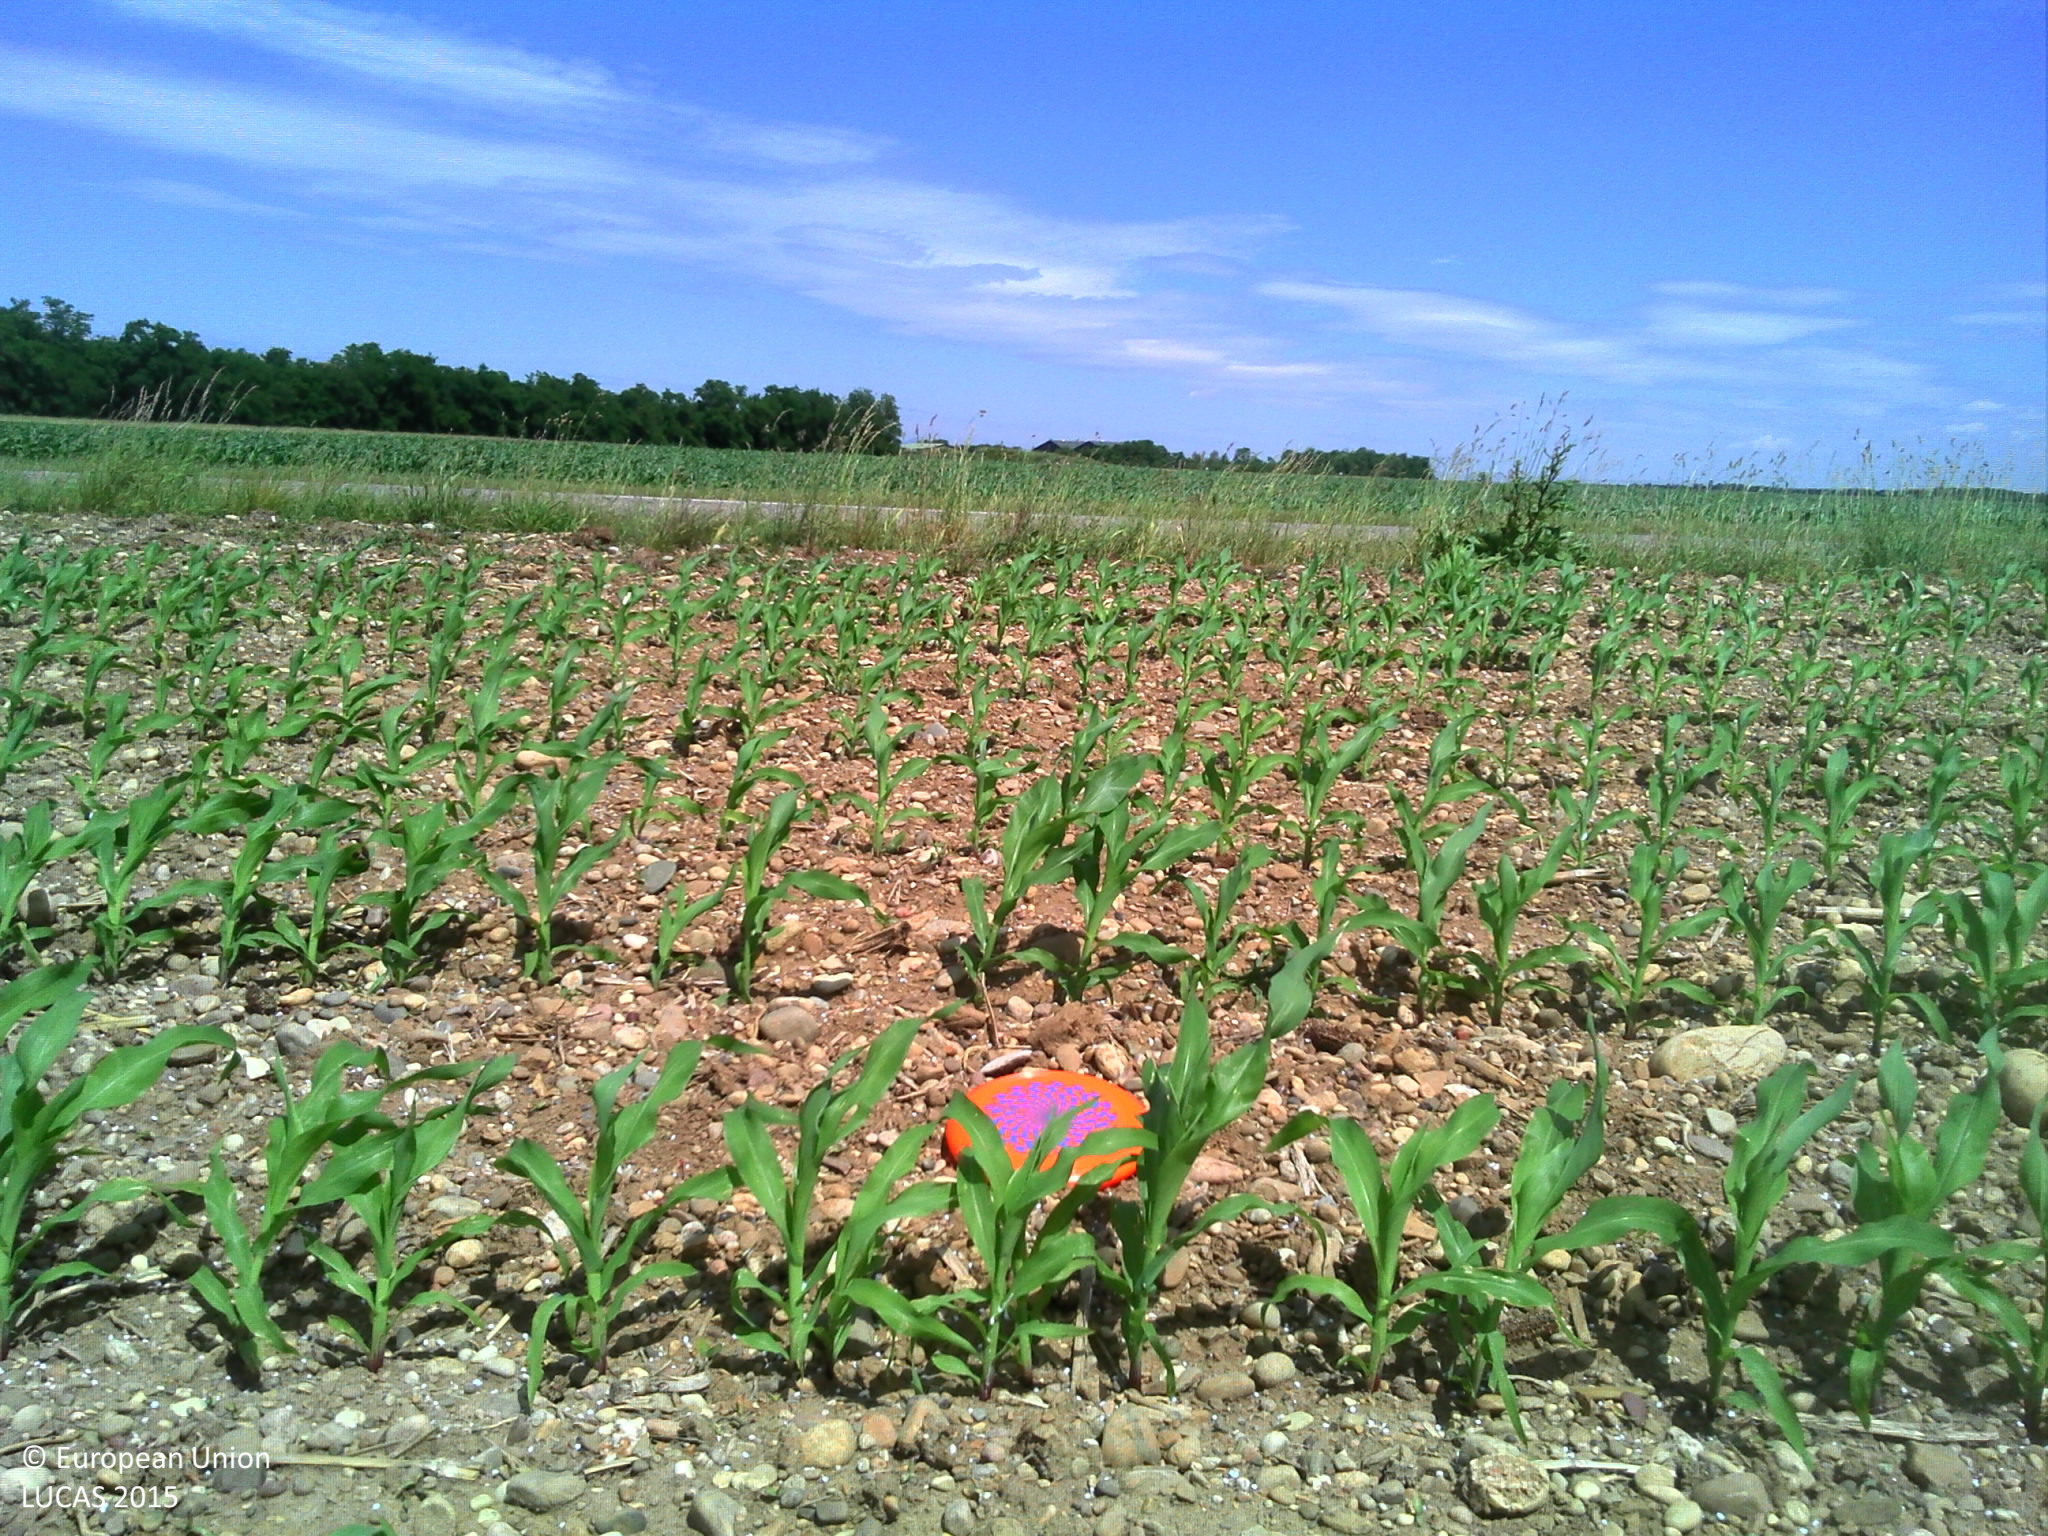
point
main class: Cropland
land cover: Maize
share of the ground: < 10 %
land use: Agriculture (excluding fallow land and kitchen gardens)
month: June
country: FR
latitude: 47.9046
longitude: 7.3926
